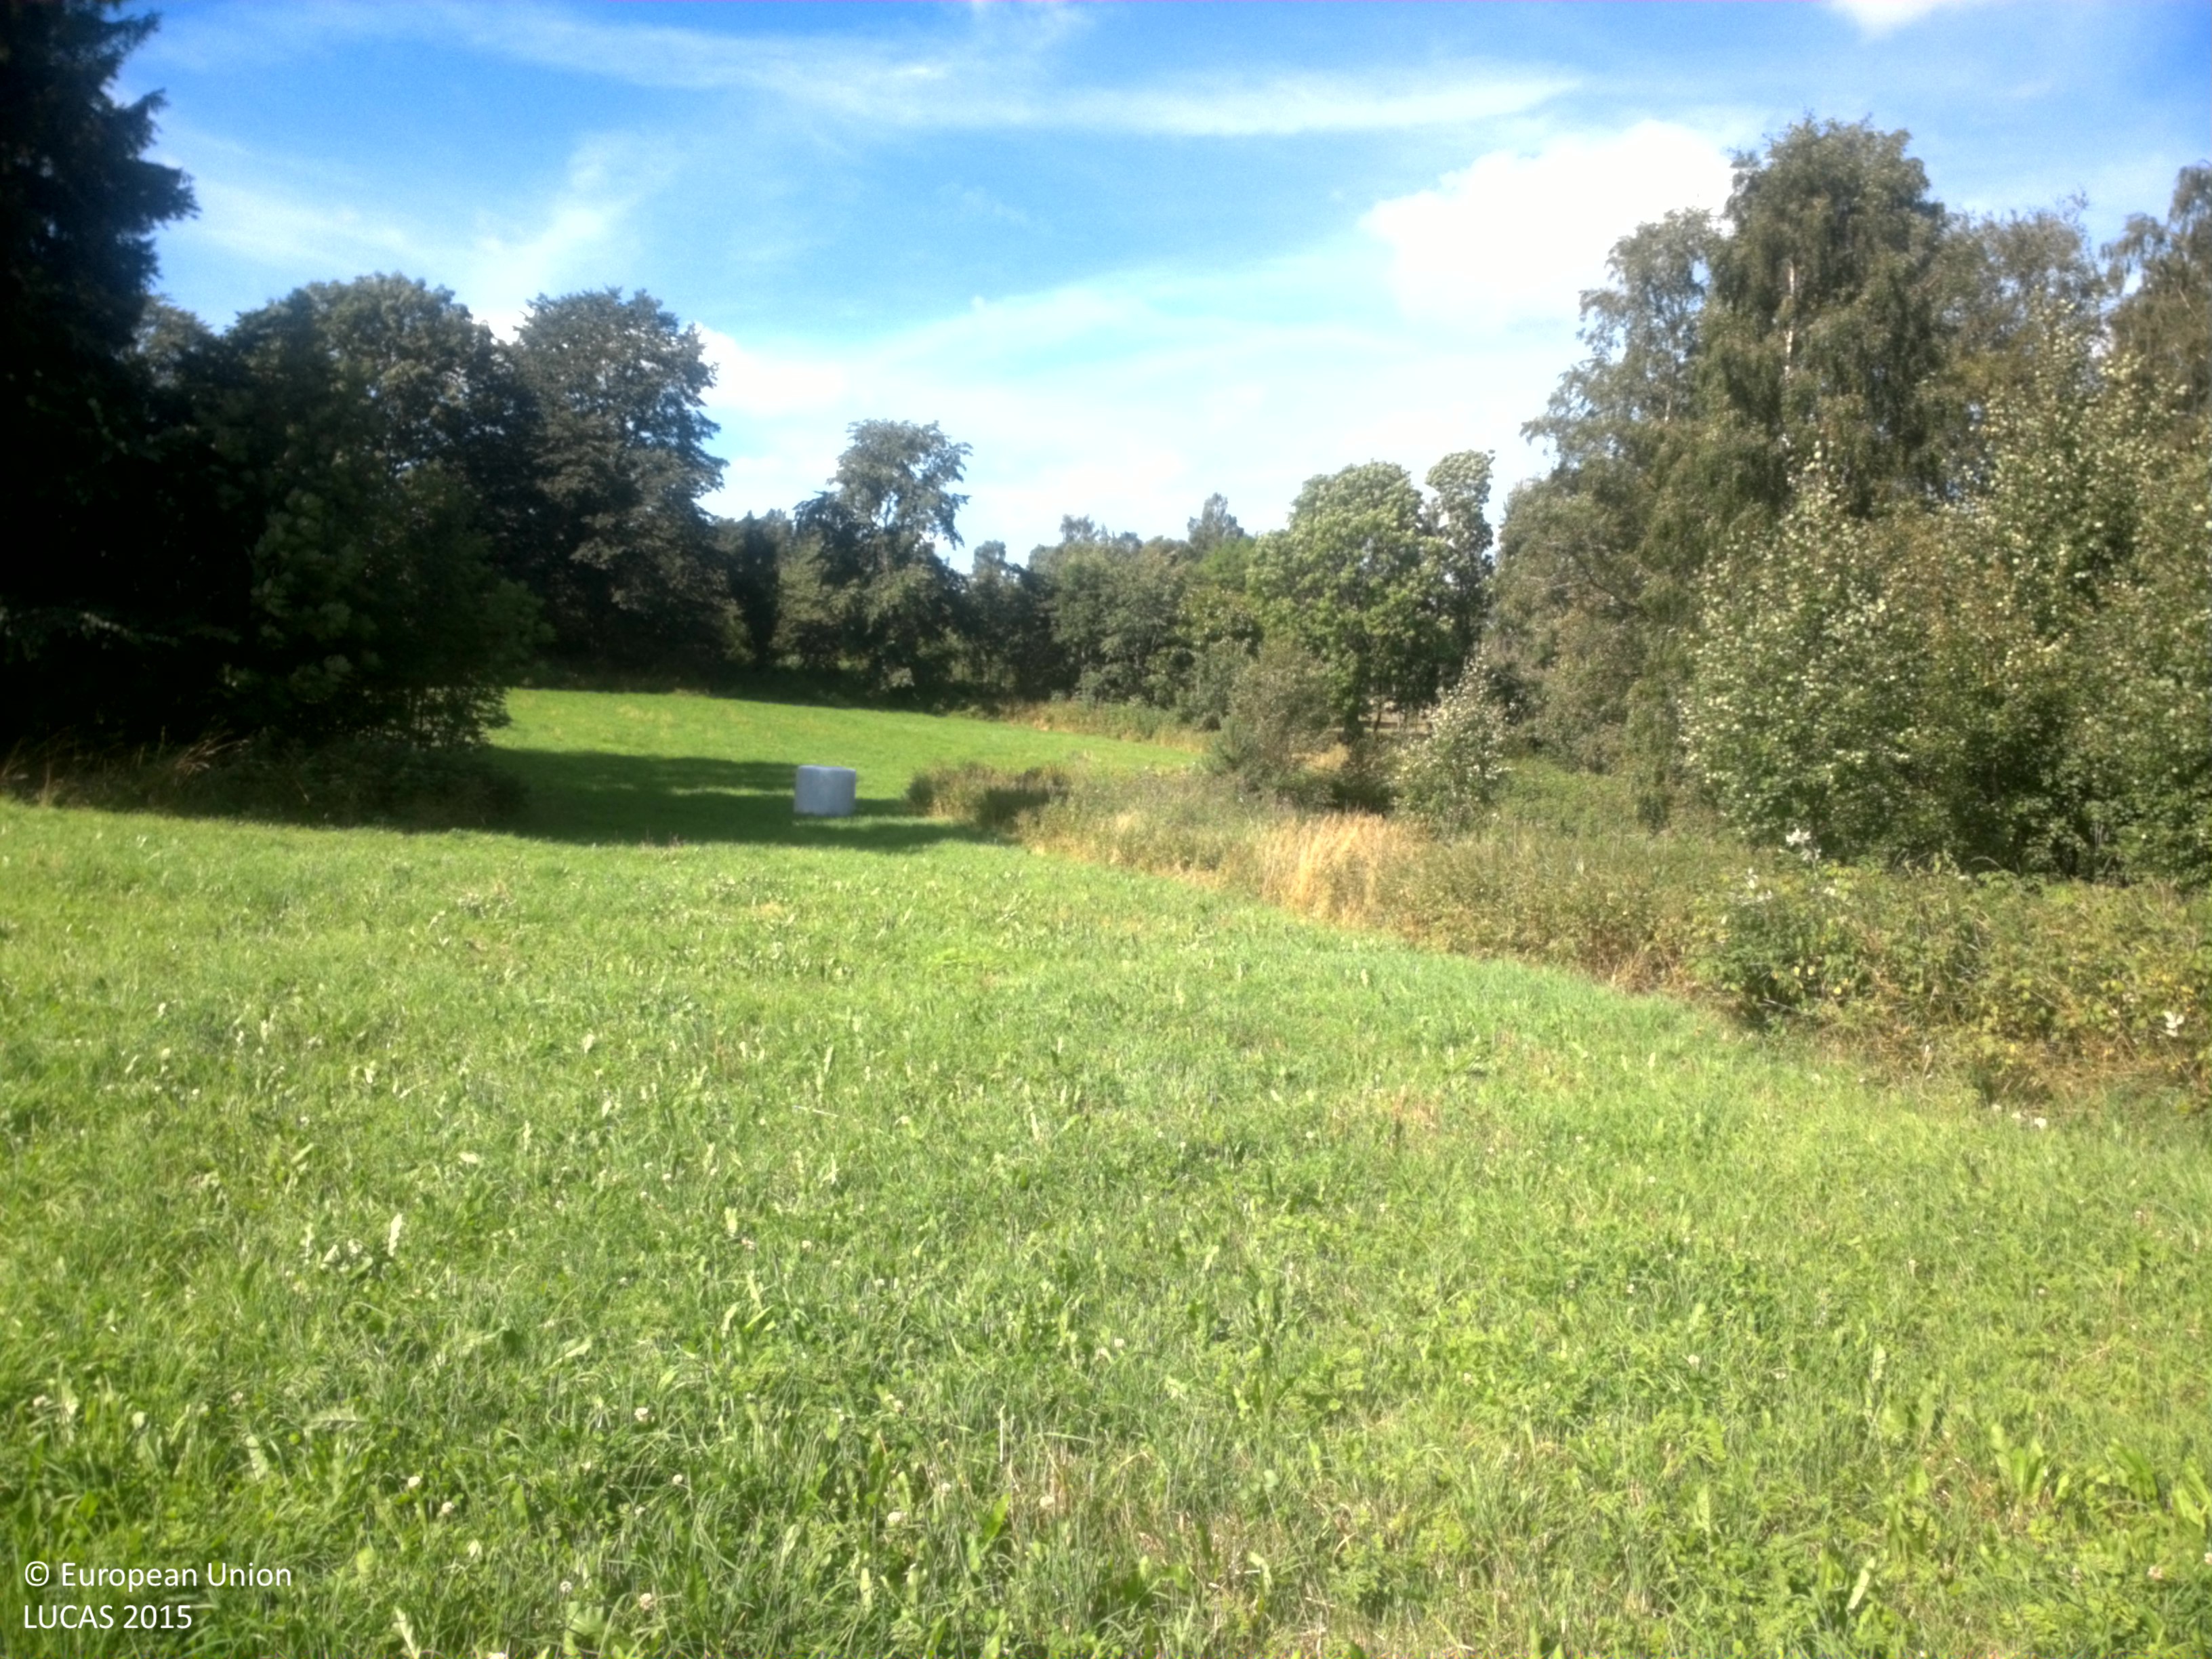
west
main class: Grassland
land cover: Grassland without tree/shrub cover
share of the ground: > 75 %
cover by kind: herbaceous plants 100 %
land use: Agriculture (excluding fallow land and kitchen gardens)
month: August
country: SE
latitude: 58.1078
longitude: 13.2700
